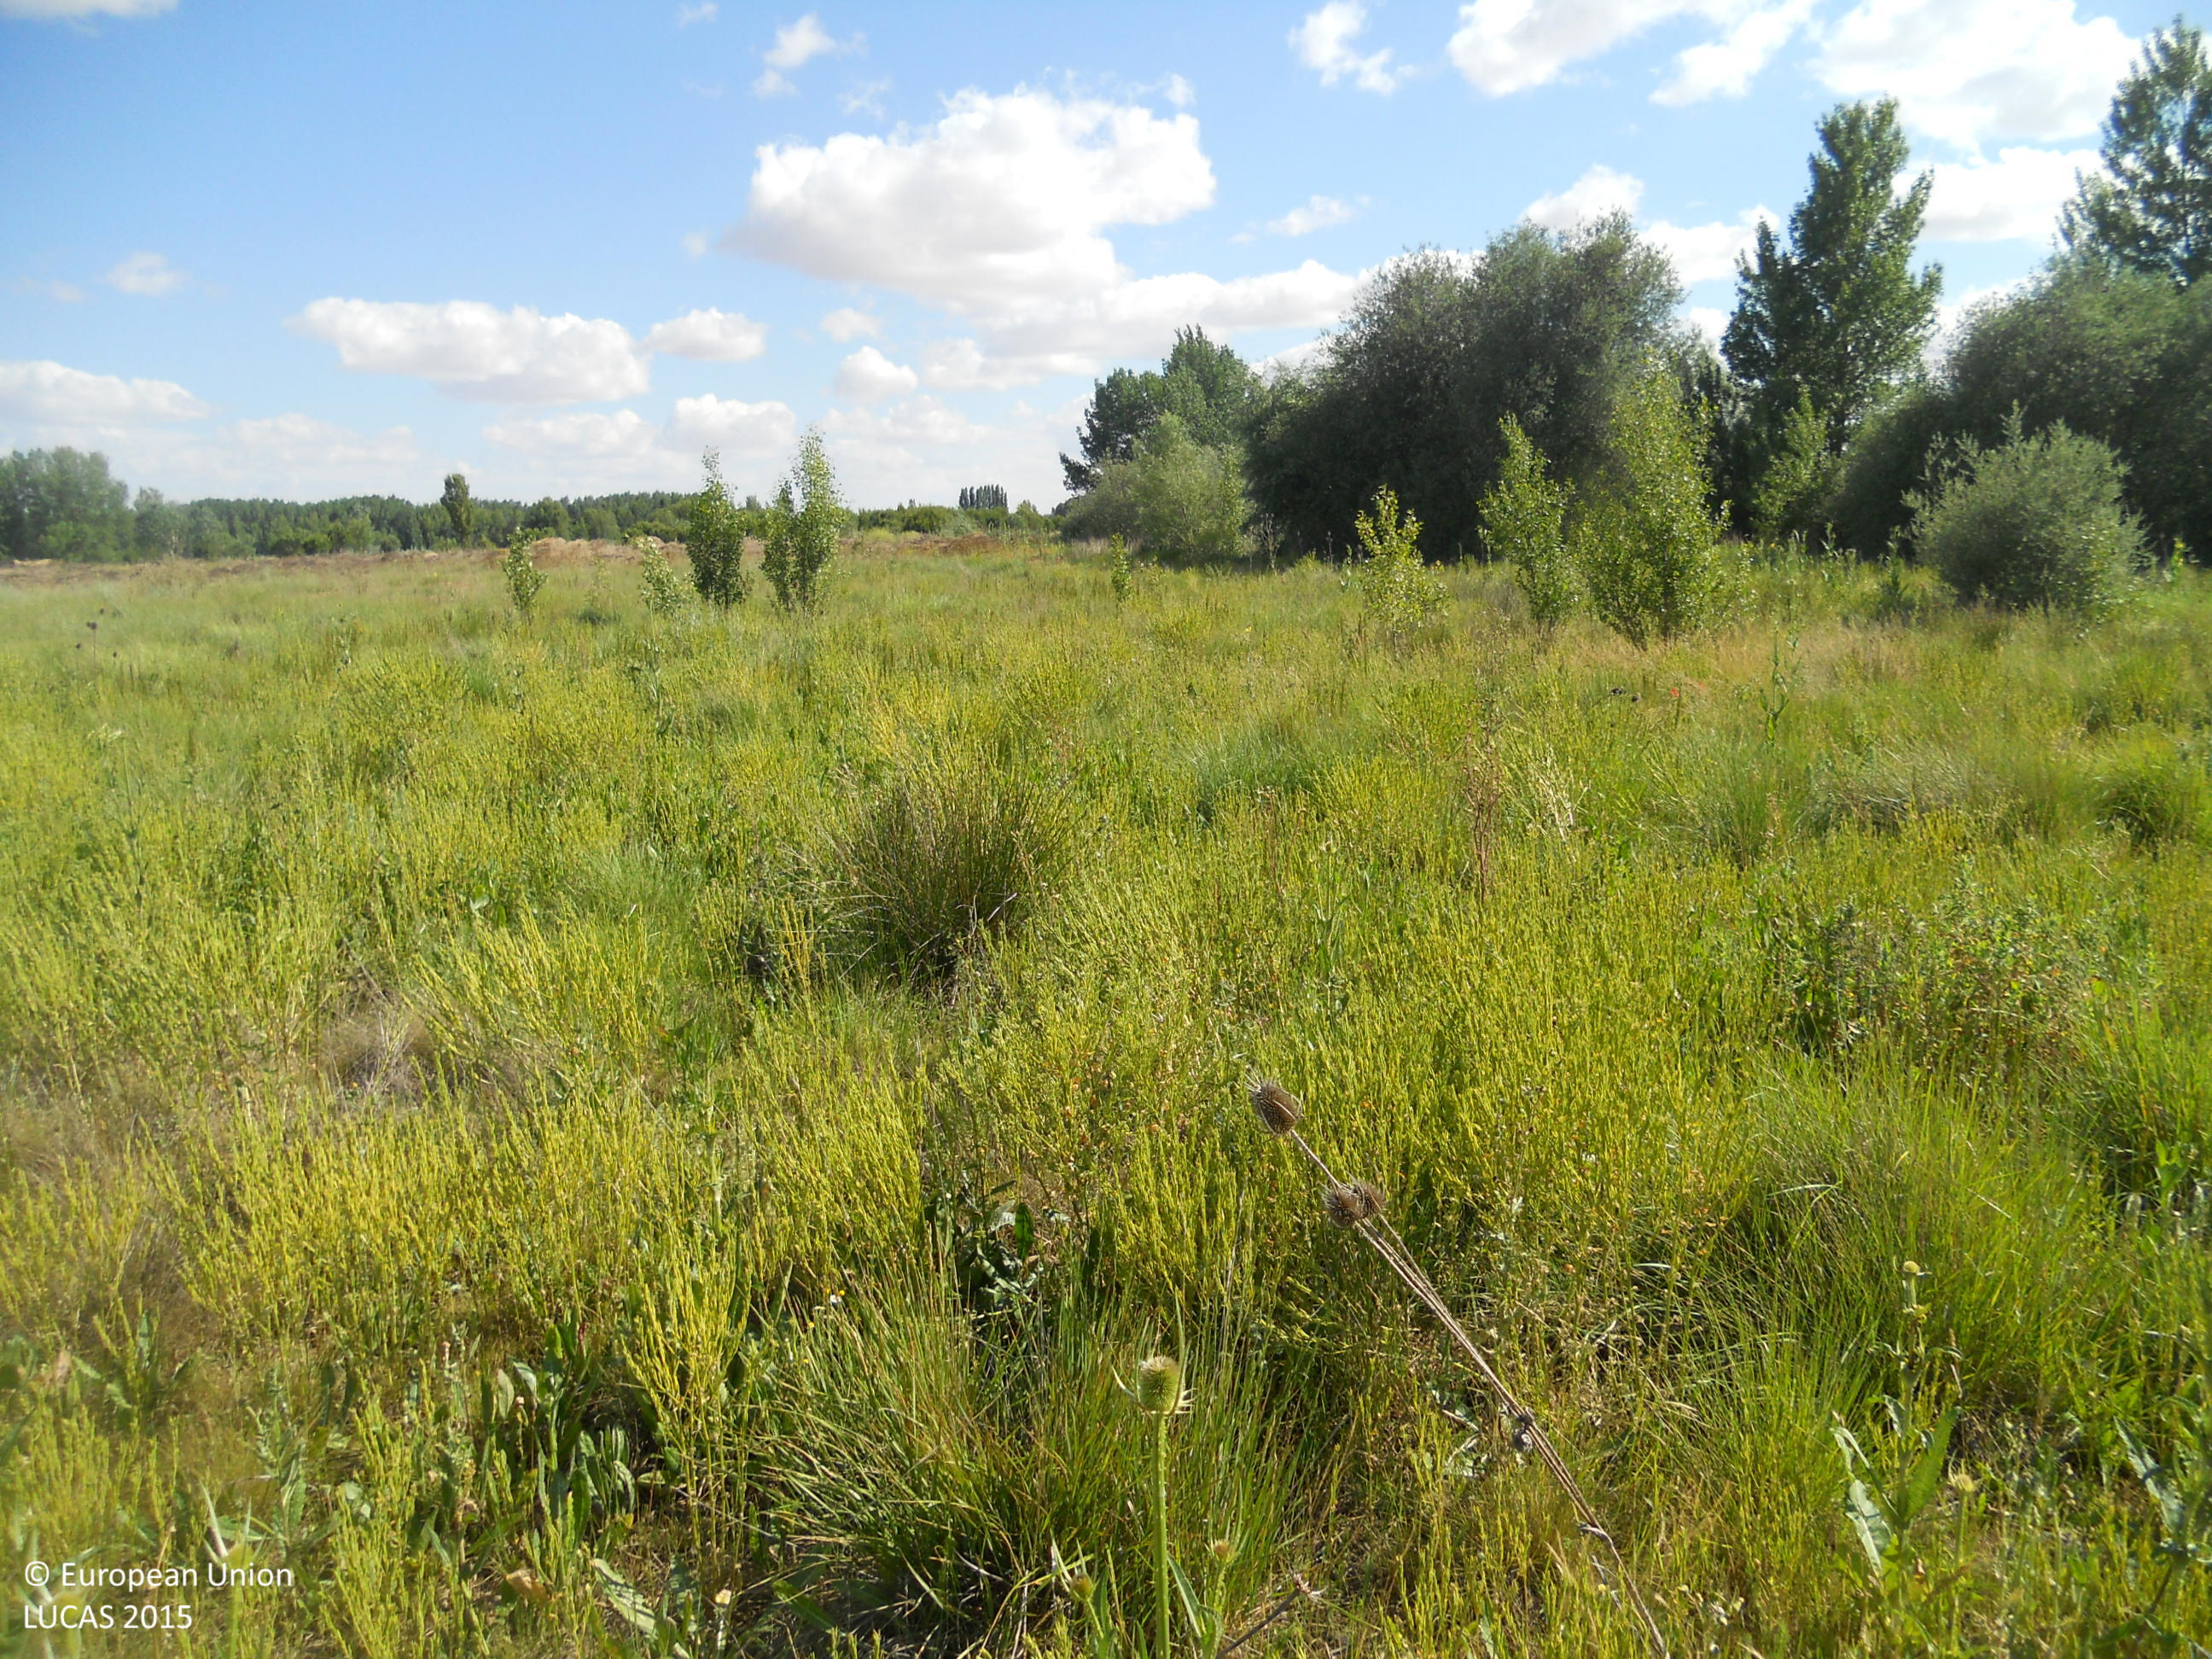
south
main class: Grassland
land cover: Grassland without tree/shrub cover
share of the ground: > 75 %
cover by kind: herbaceous plants 100 %
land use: Abandoned areas
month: June
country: ES
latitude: 42.2087
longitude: -5.2383
